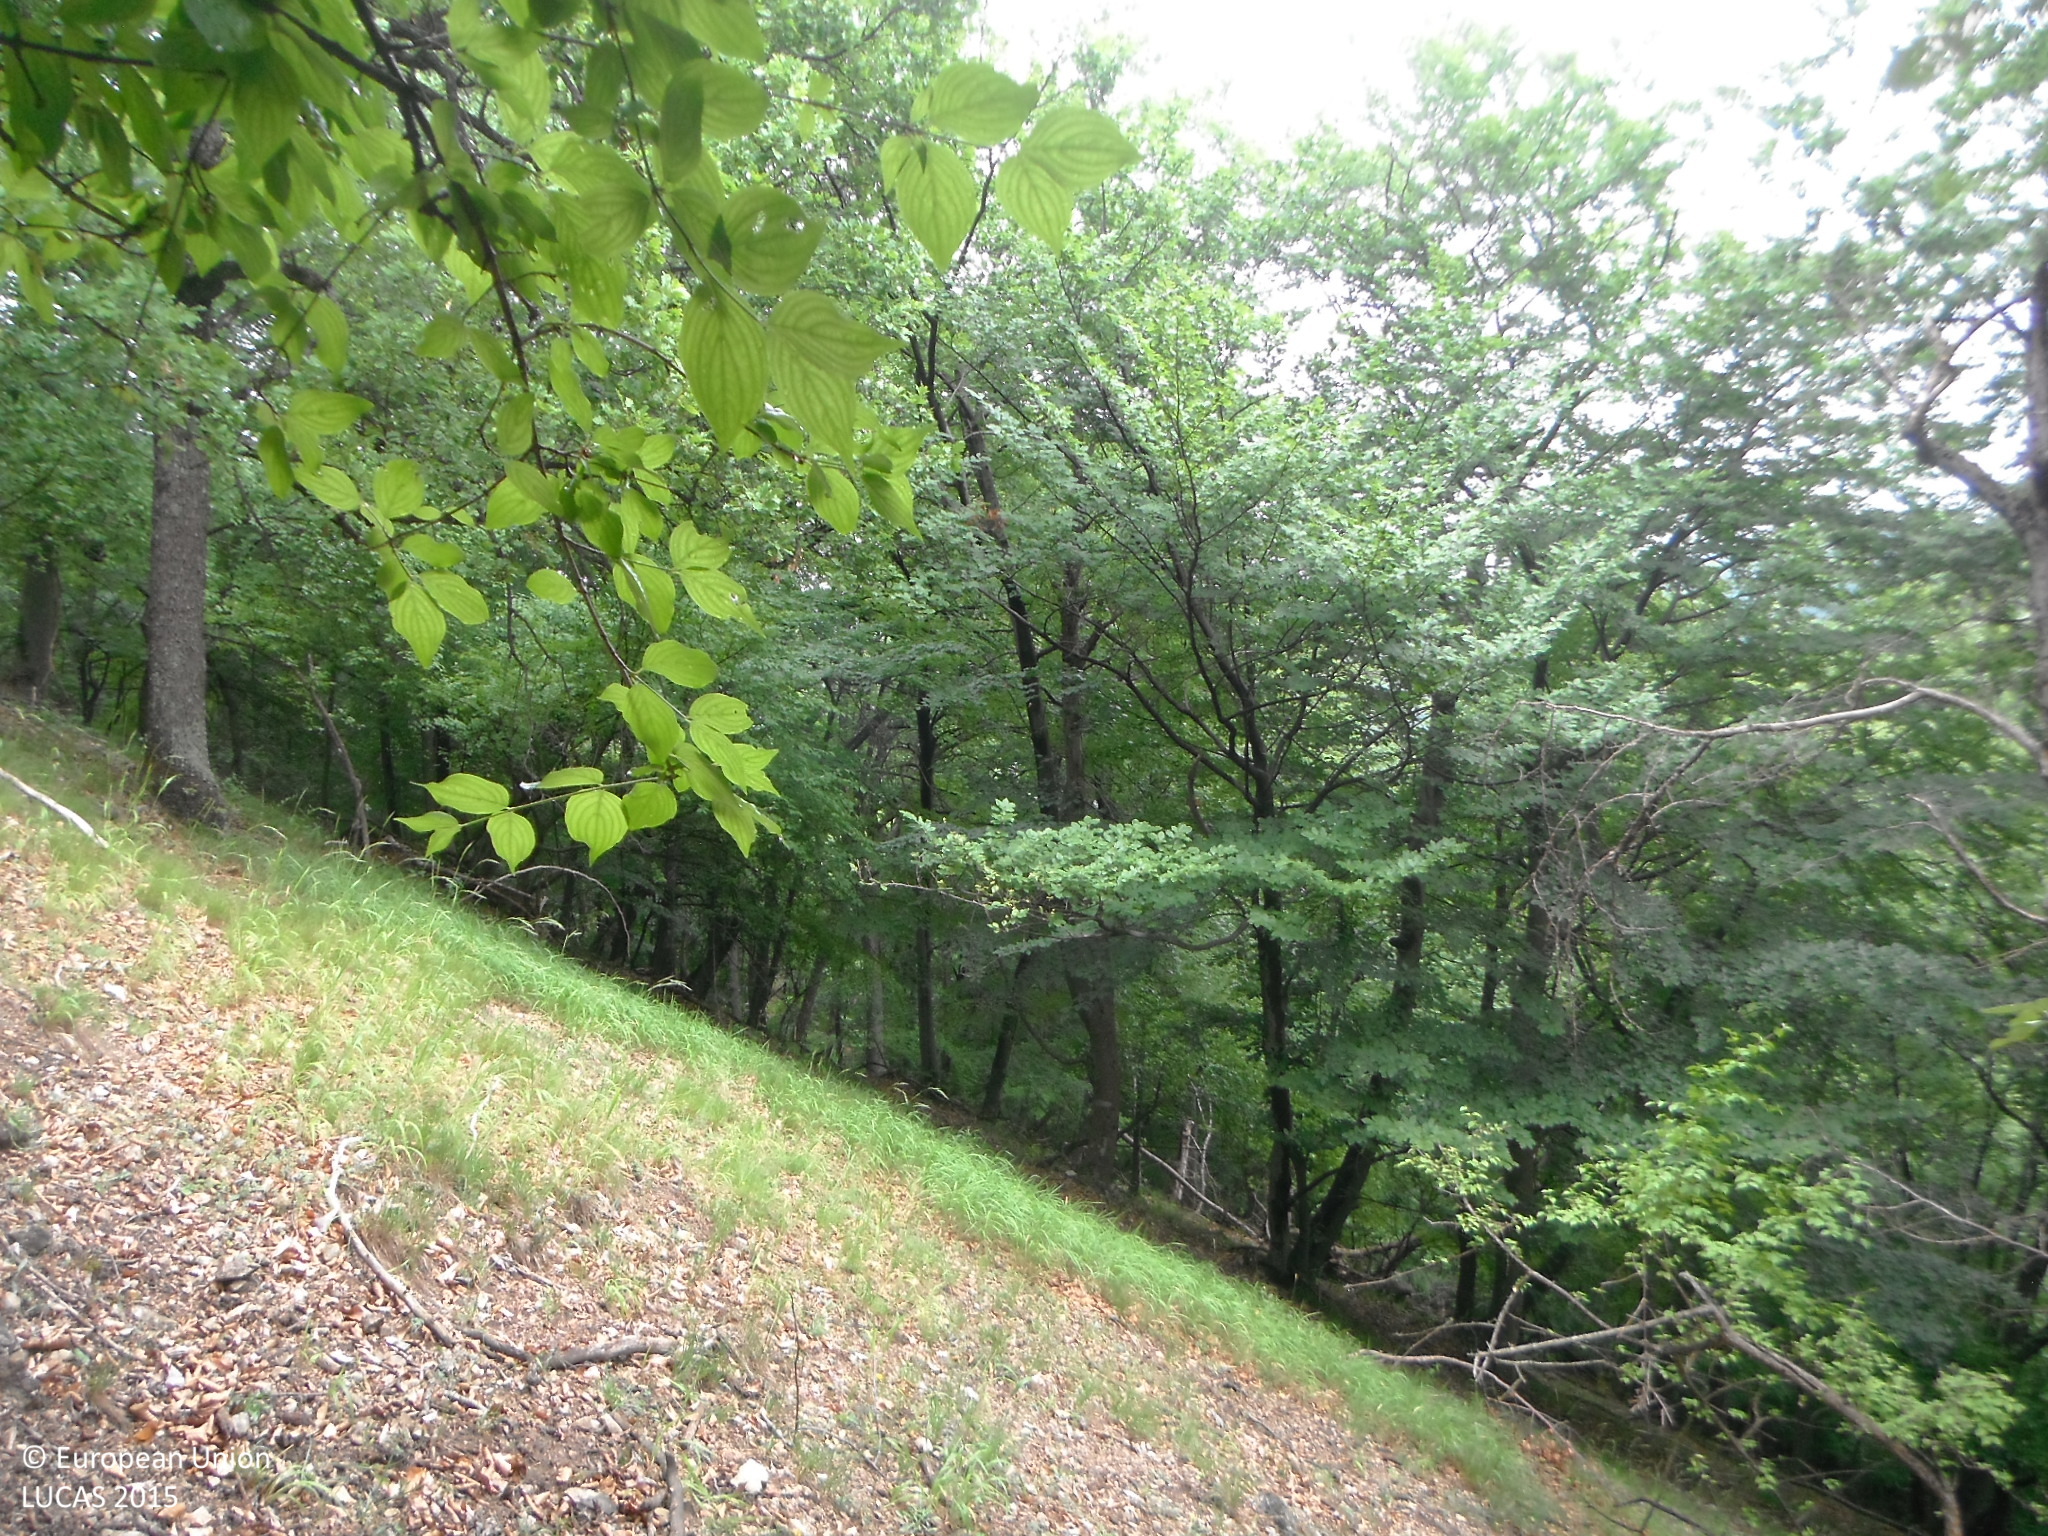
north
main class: Woodland
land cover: Broadleaved woodland
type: beech forest
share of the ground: > 75 %
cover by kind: broadleaved forest trees 80 %, herbaceous plants 15 %, shrubs 5 %
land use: Forestry
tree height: > 5 m
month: June
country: SK
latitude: 48.7541
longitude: 18.3817
